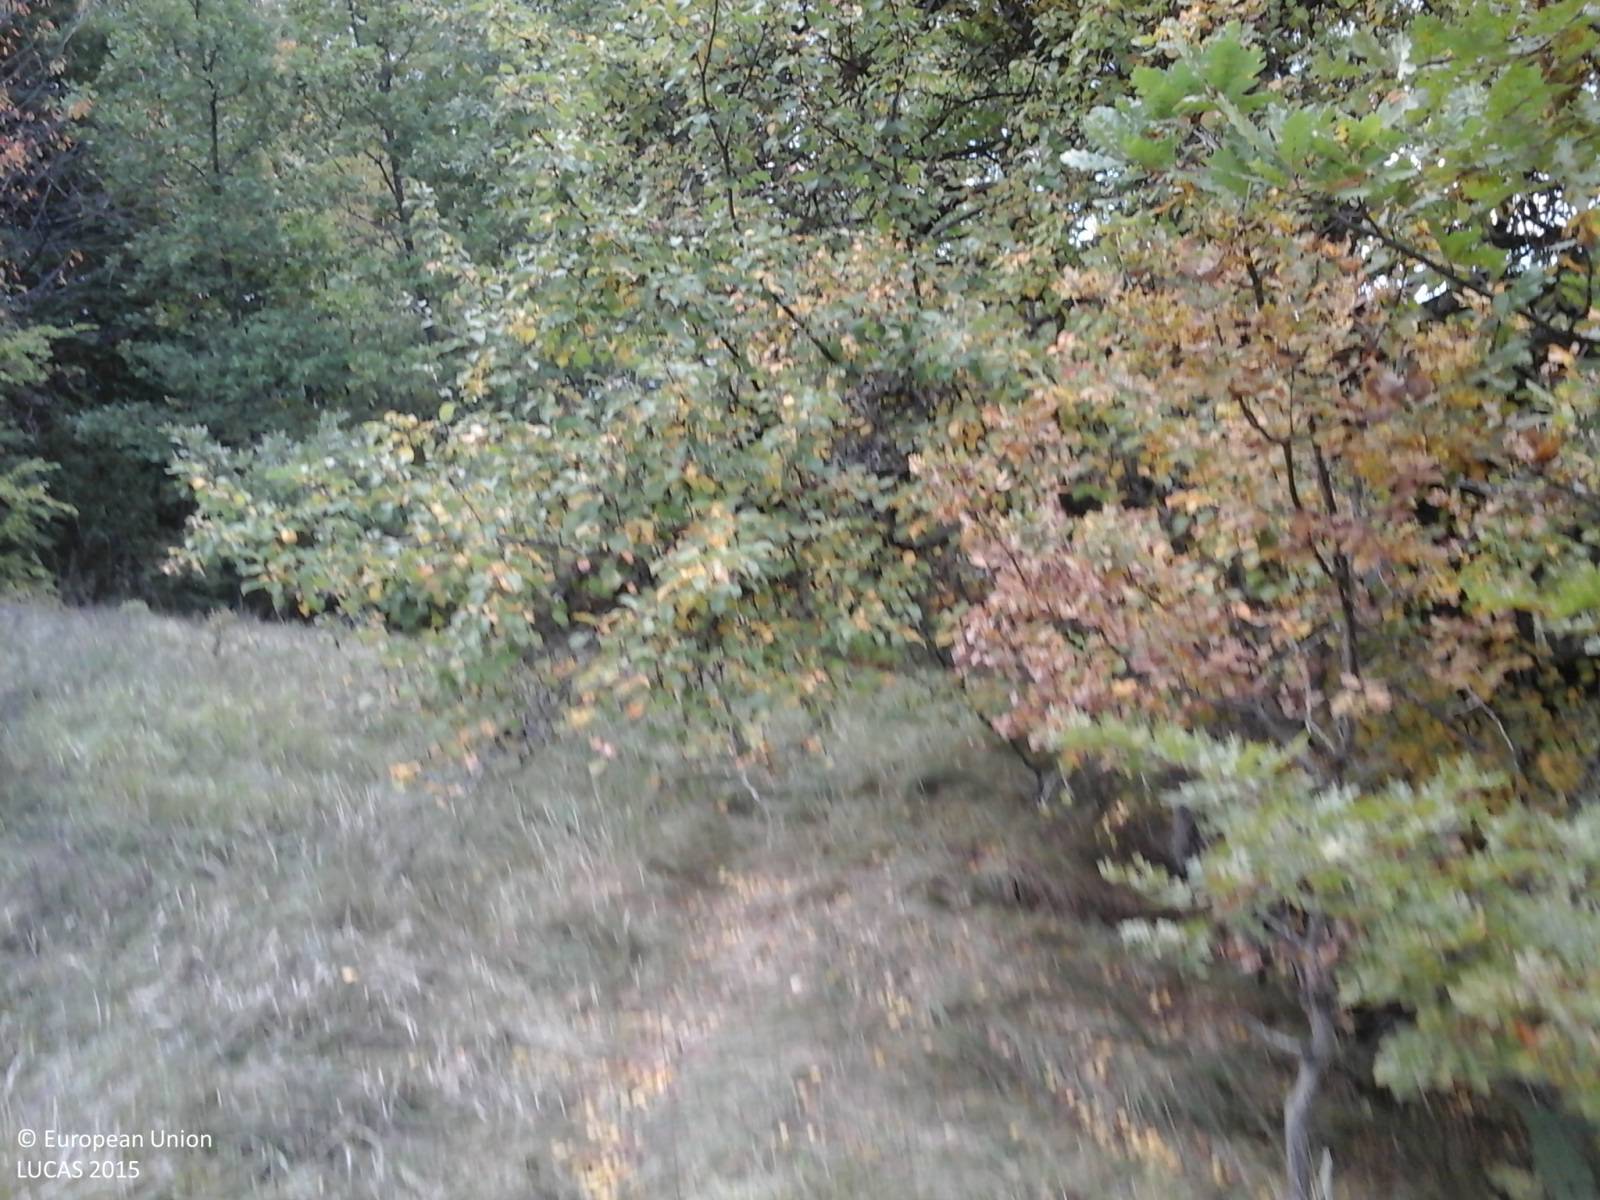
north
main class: Shrubland
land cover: Shrubland with sparse tree cover
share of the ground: > 75 %
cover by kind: shrubs 80 %, herbaceous plants 15 %, broadleaved forest trees 5 %
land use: Semi-natural and natural areas not in use
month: October
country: IT
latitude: 42.5502
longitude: 13.1686
